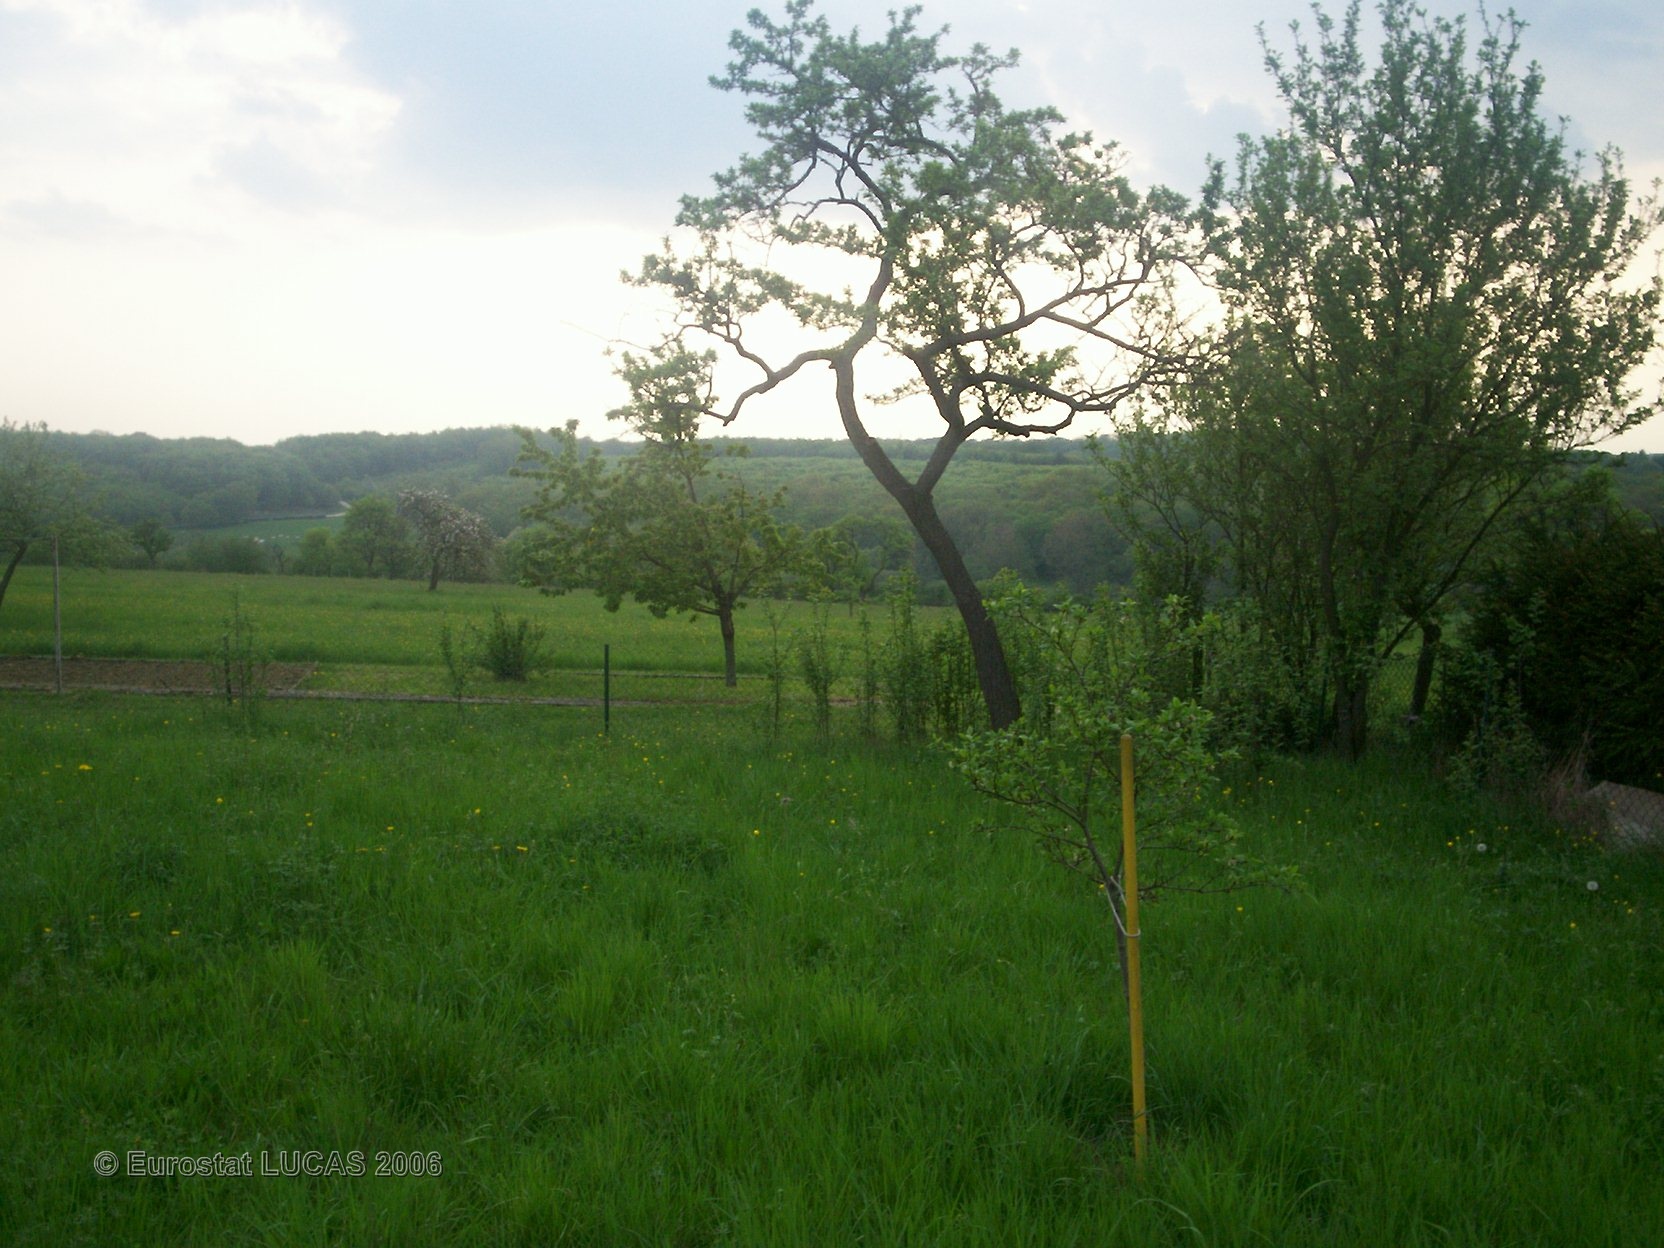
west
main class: Grassland
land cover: Grassland with sparse tree/shrub cover
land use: Agriculture (excluding fallow land and kitchen gardens)
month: May
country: FR
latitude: 48.7775
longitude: 7.0204
